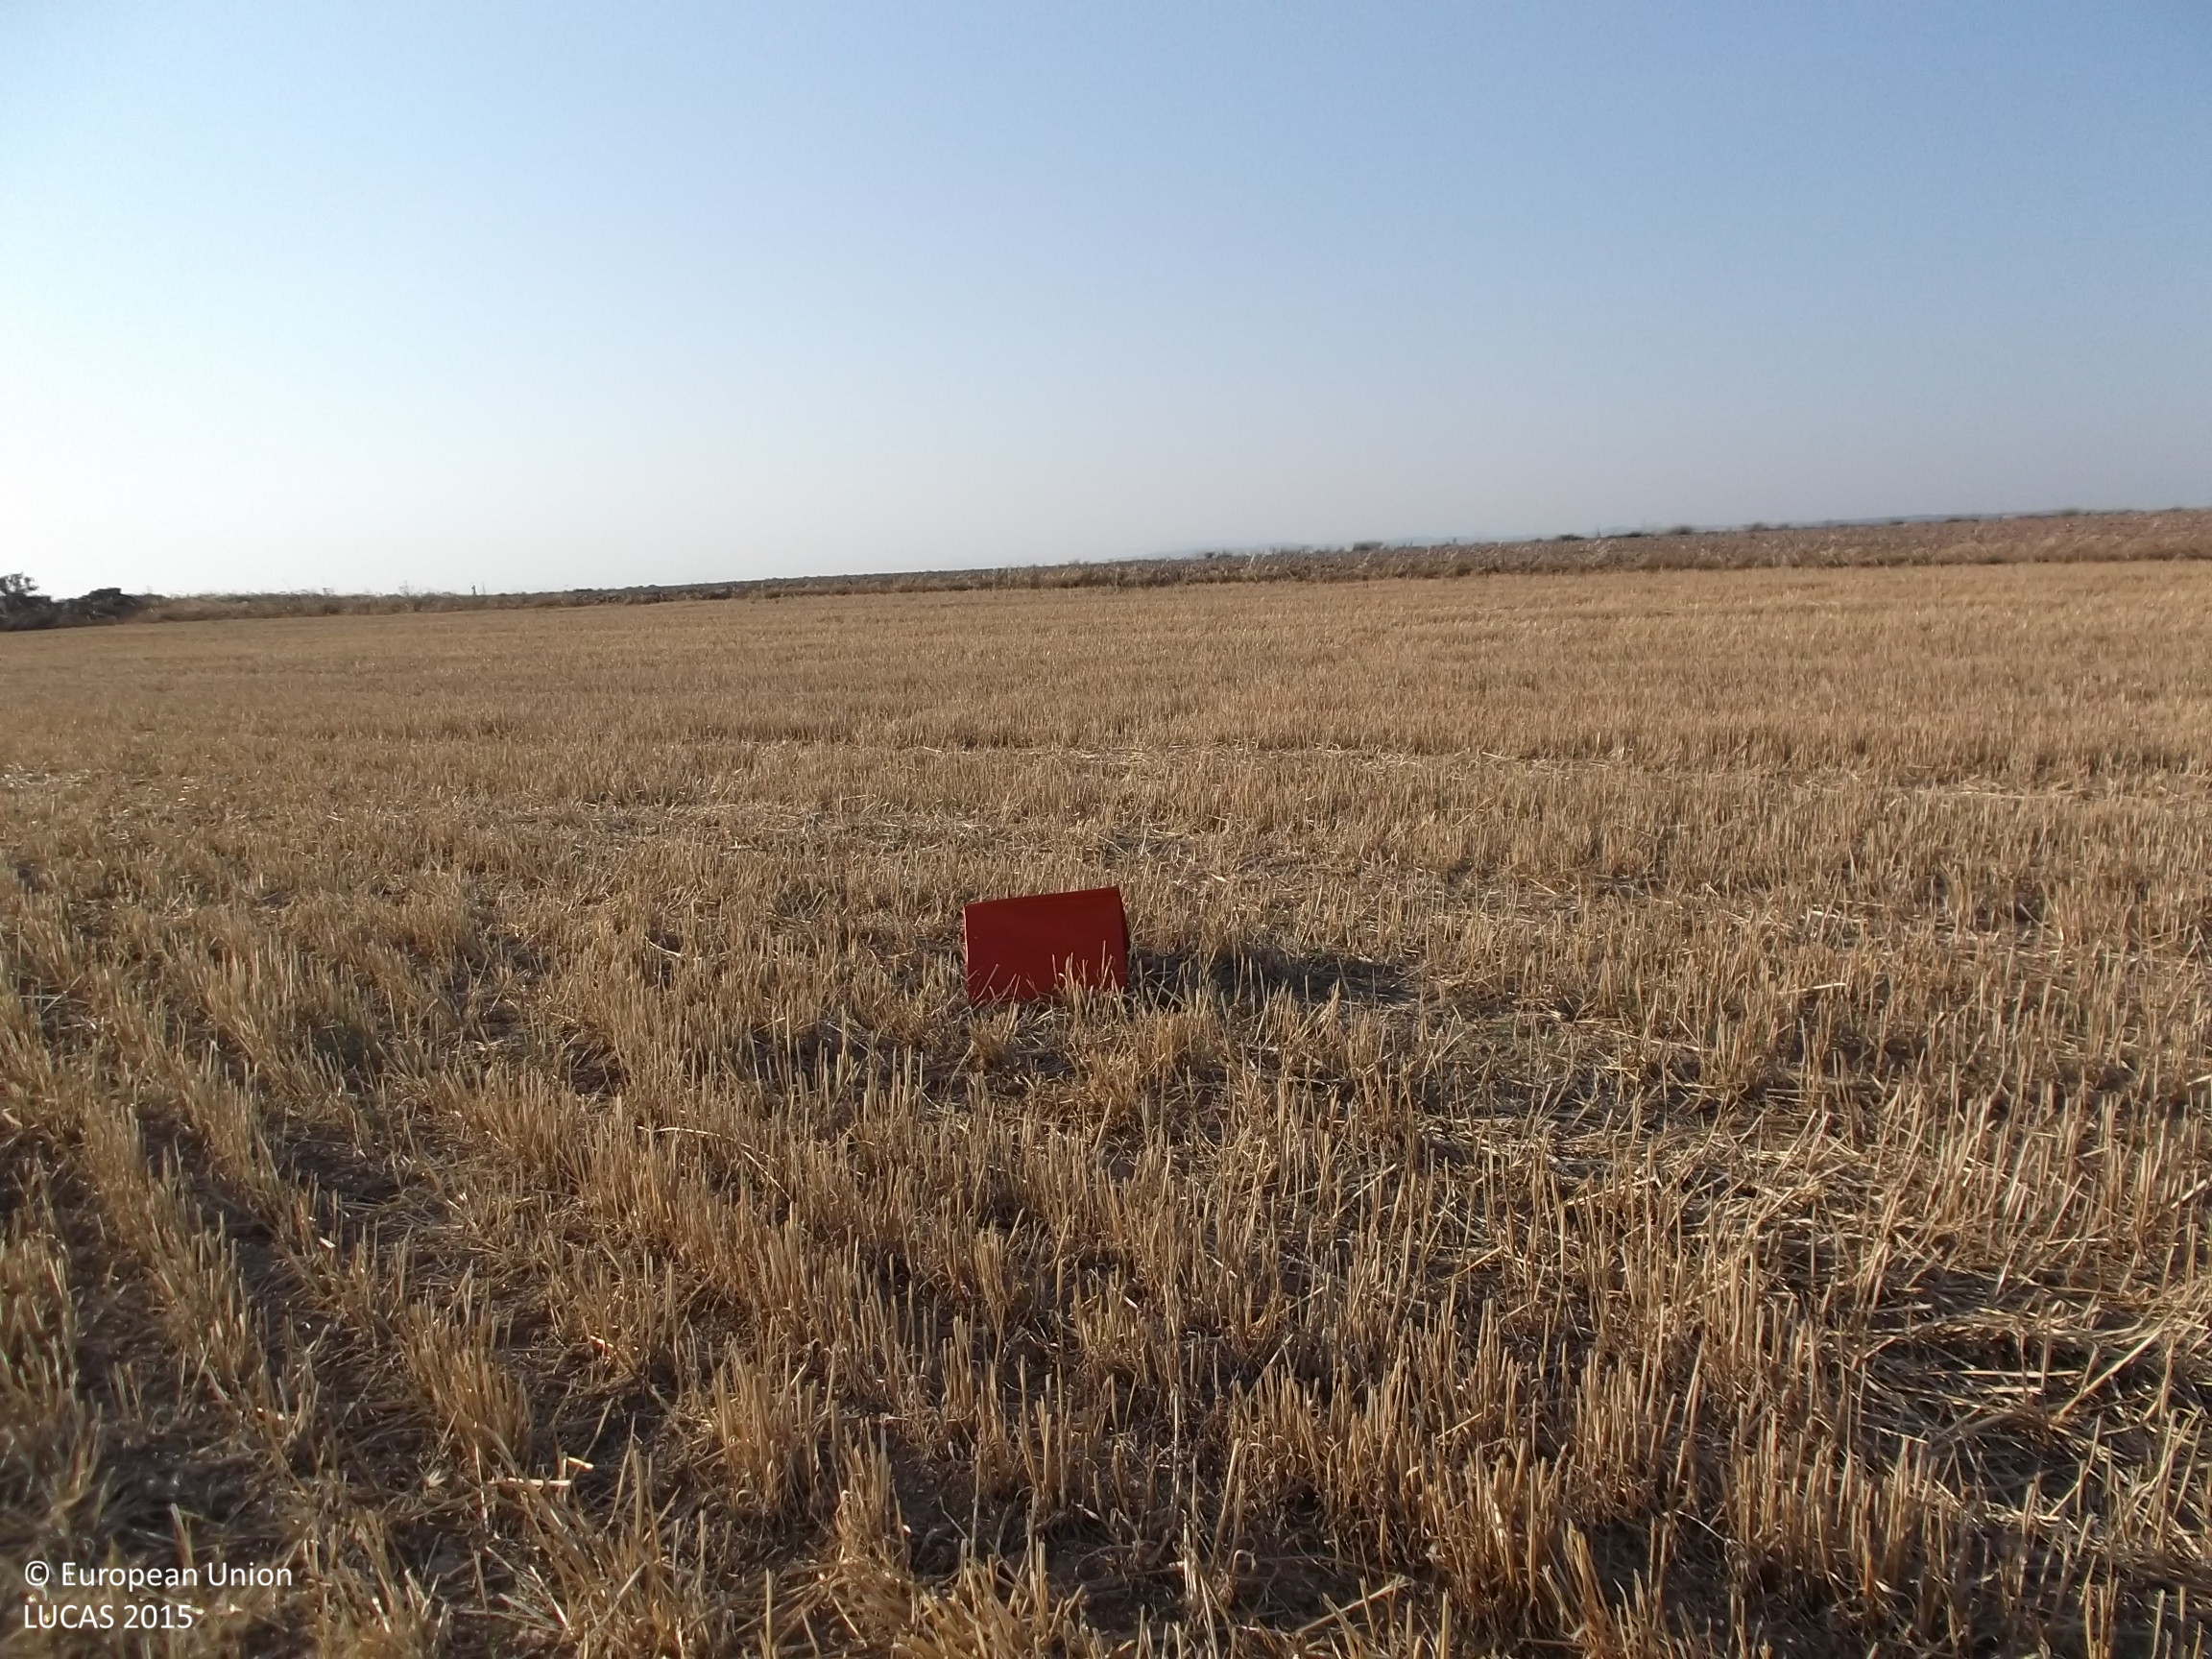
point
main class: Cropland
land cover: Barley
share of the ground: < 10 %
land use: Agriculture (excluding fallow land and kitchen gardens)
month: July
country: ES
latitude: 42.2808
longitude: -1.5656
